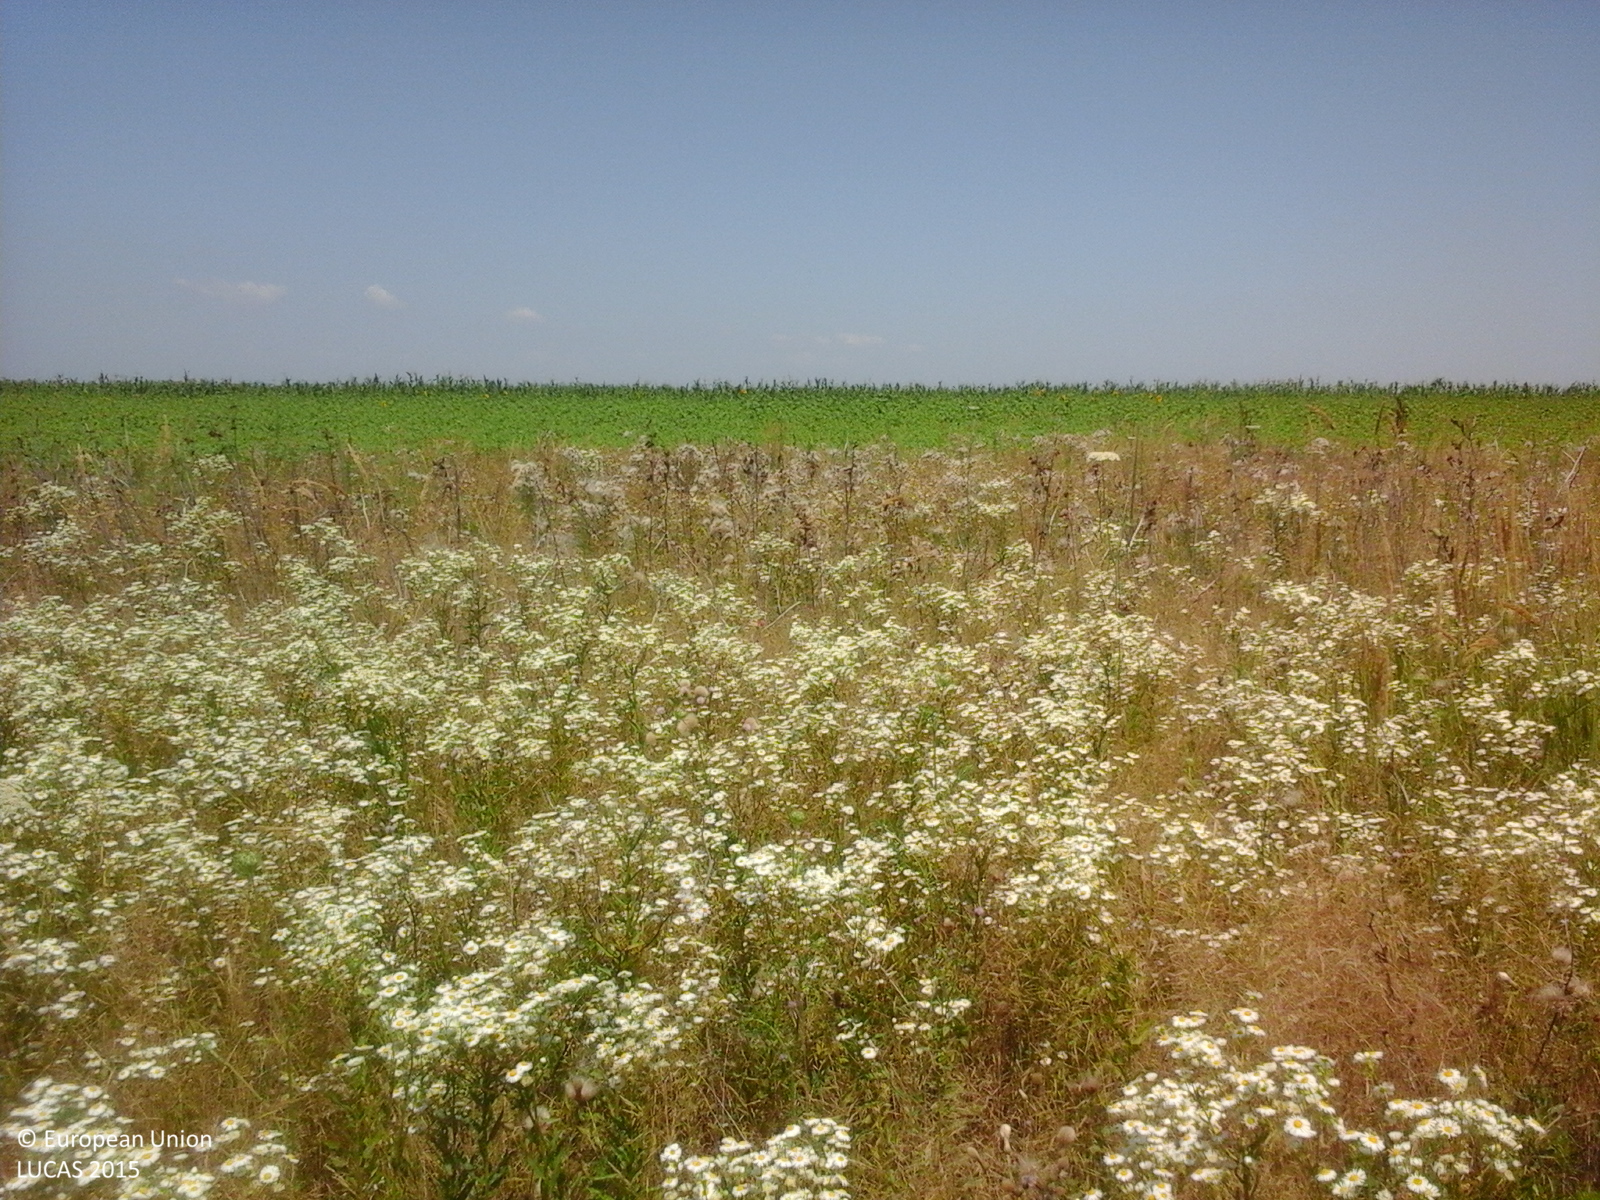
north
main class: Grassland
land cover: Spontaneously vegetated surfaces
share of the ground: > 75 %
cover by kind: herbaceous plants 100 %
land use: Fallow land
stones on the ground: 10 - 25 %
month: July
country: RO
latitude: 44.2330
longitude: 24.5553
